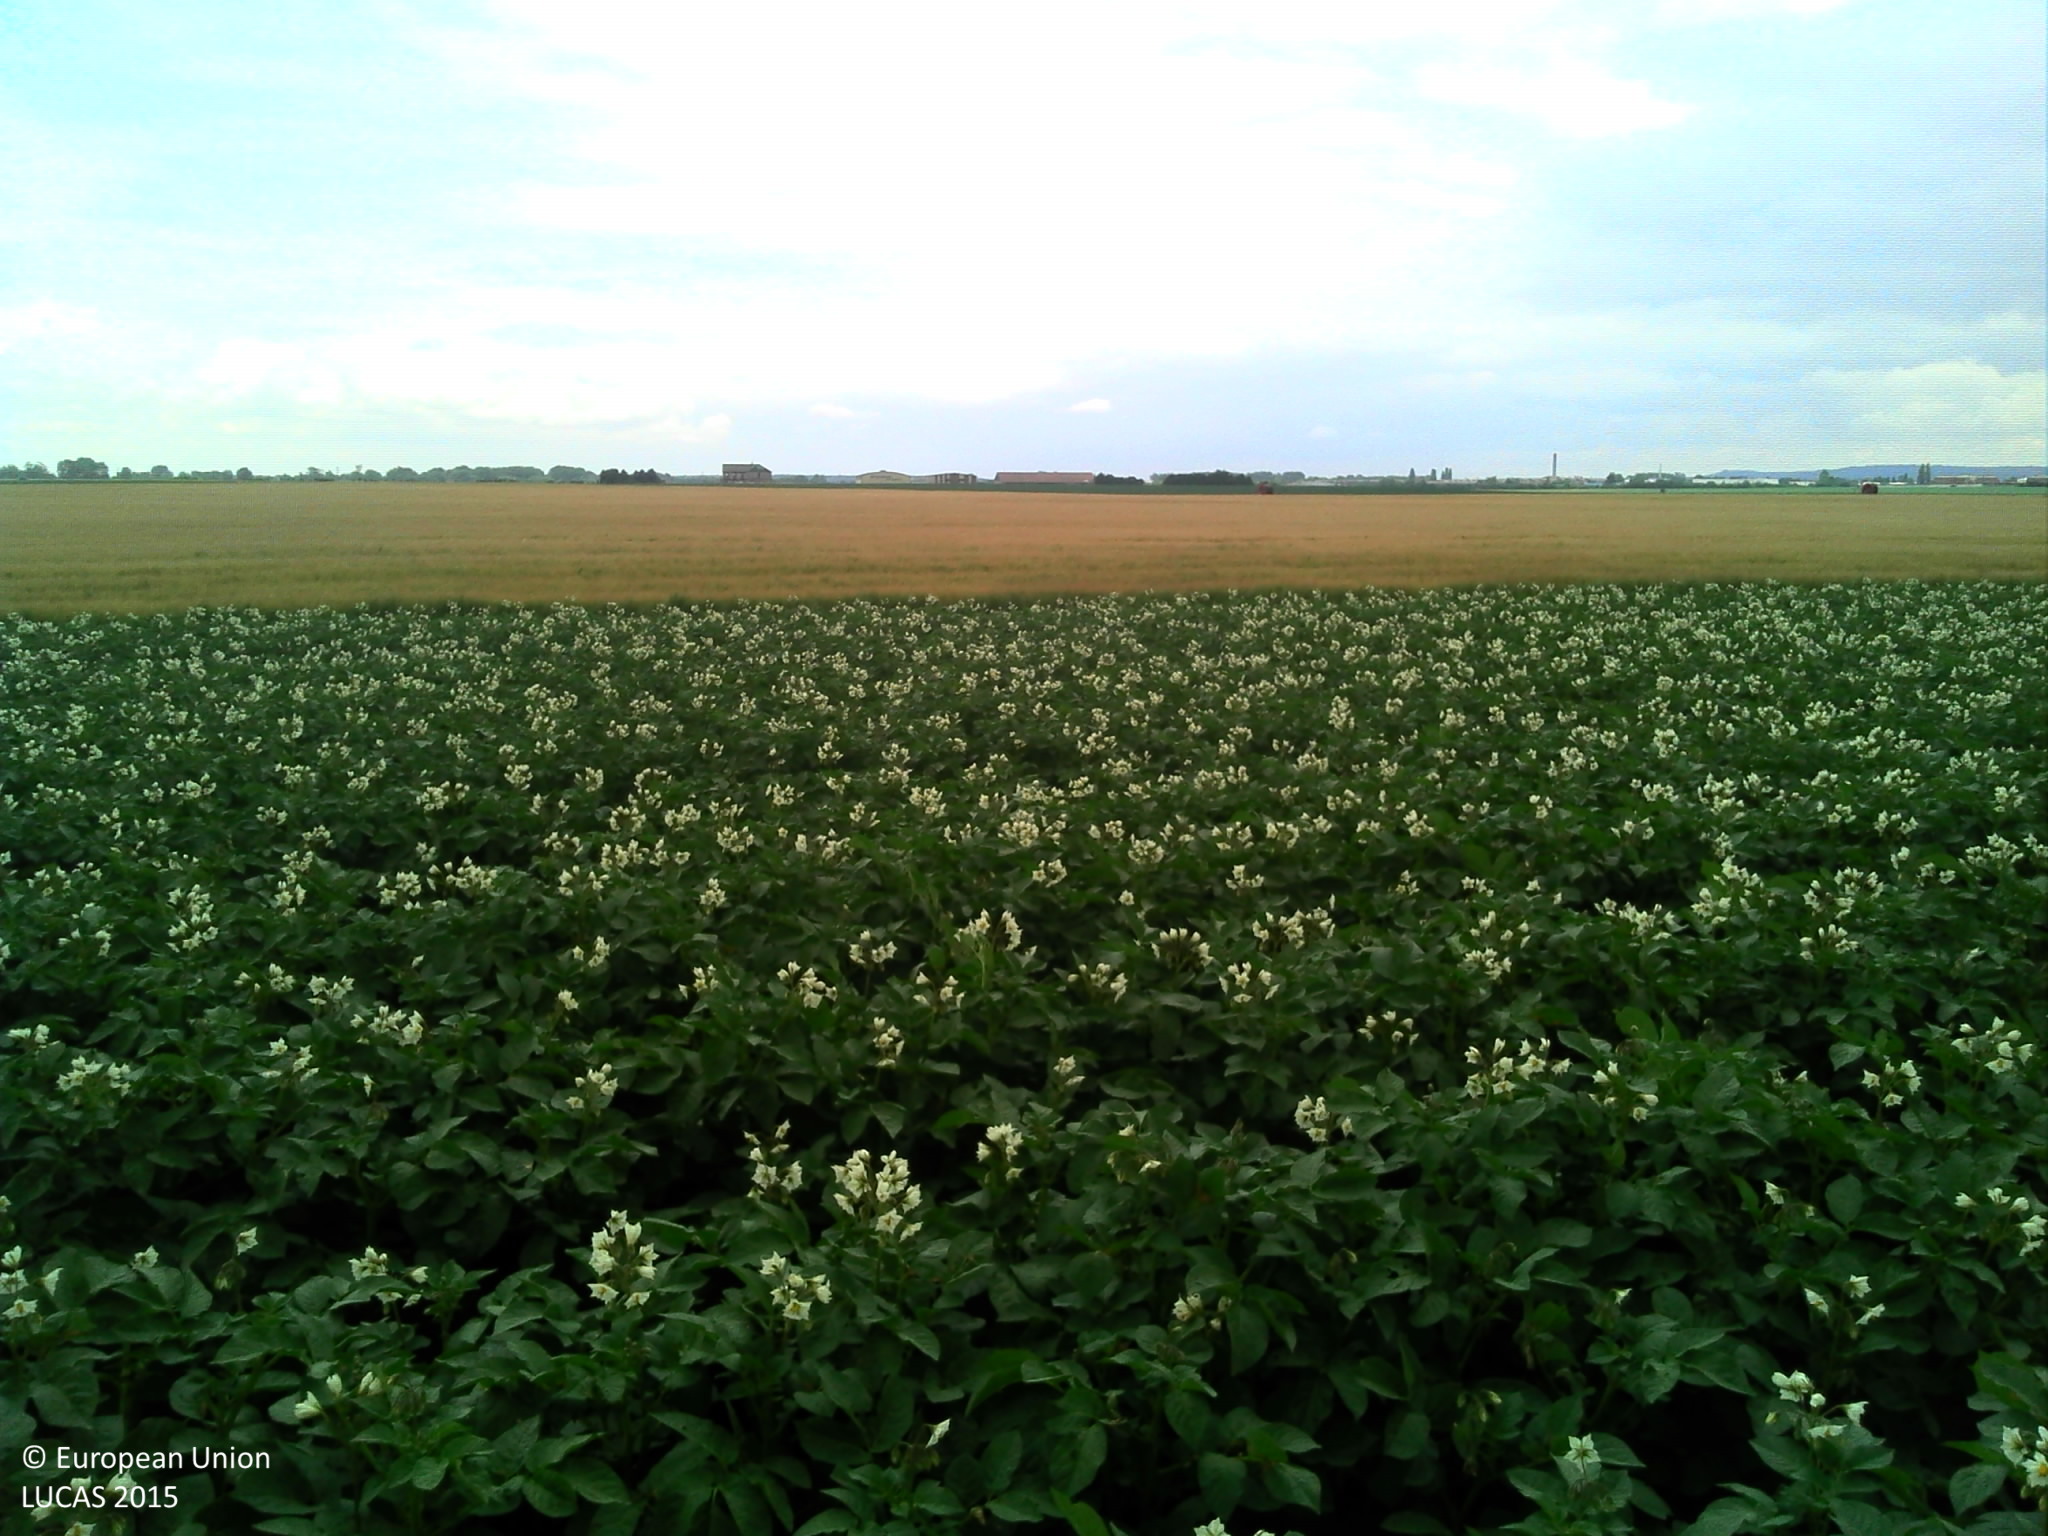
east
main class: Cropland
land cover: Potatoes
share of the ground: > 75 %
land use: Agriculture (excluding fallow land and kitchen gardens)
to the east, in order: Potatoes; Barley
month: June
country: FR
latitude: 49.5904
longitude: 3.6159
